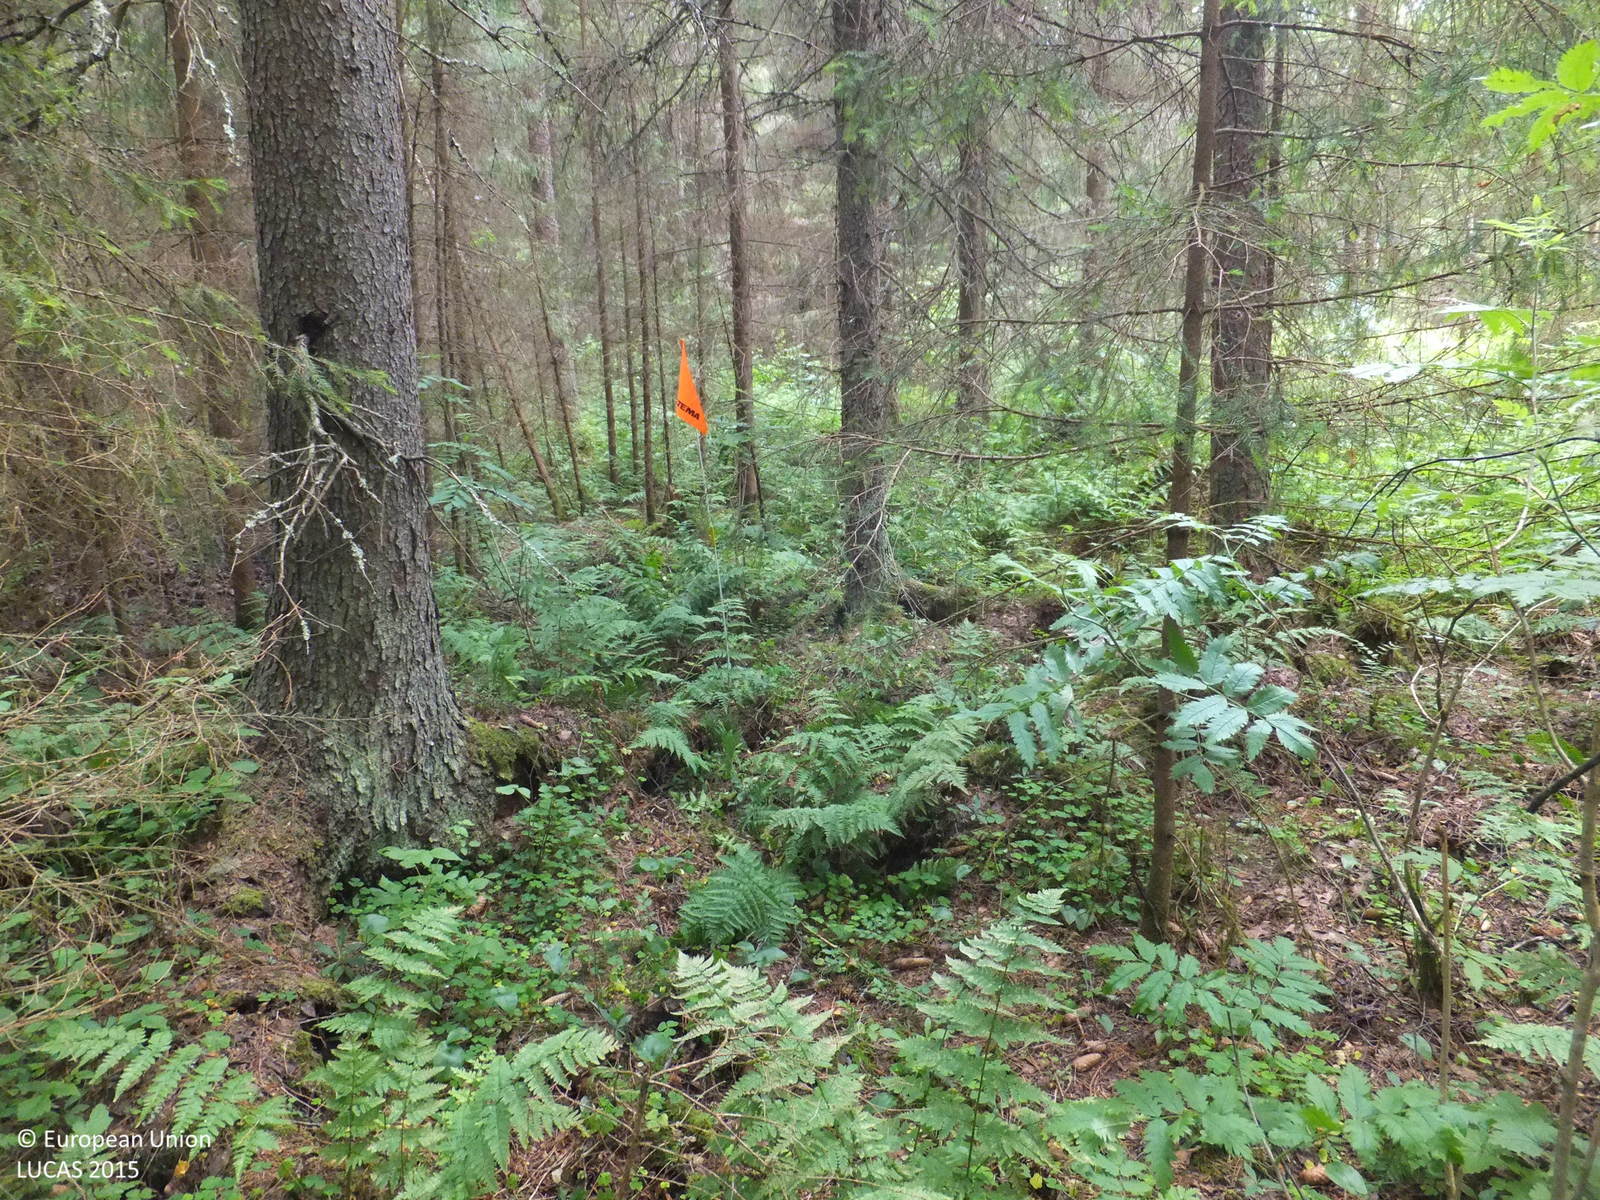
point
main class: Woodland
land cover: Other mixed woodland
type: boreal forest
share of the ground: > 75 %
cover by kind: coniferous forest trees 60 %, broadleaved forest trees 30 %, herbaceous plants 5 %, lichens and mosses 5 %
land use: Forestry
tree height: > 5 m
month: July
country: FI
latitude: 63.6530
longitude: 23.2853
